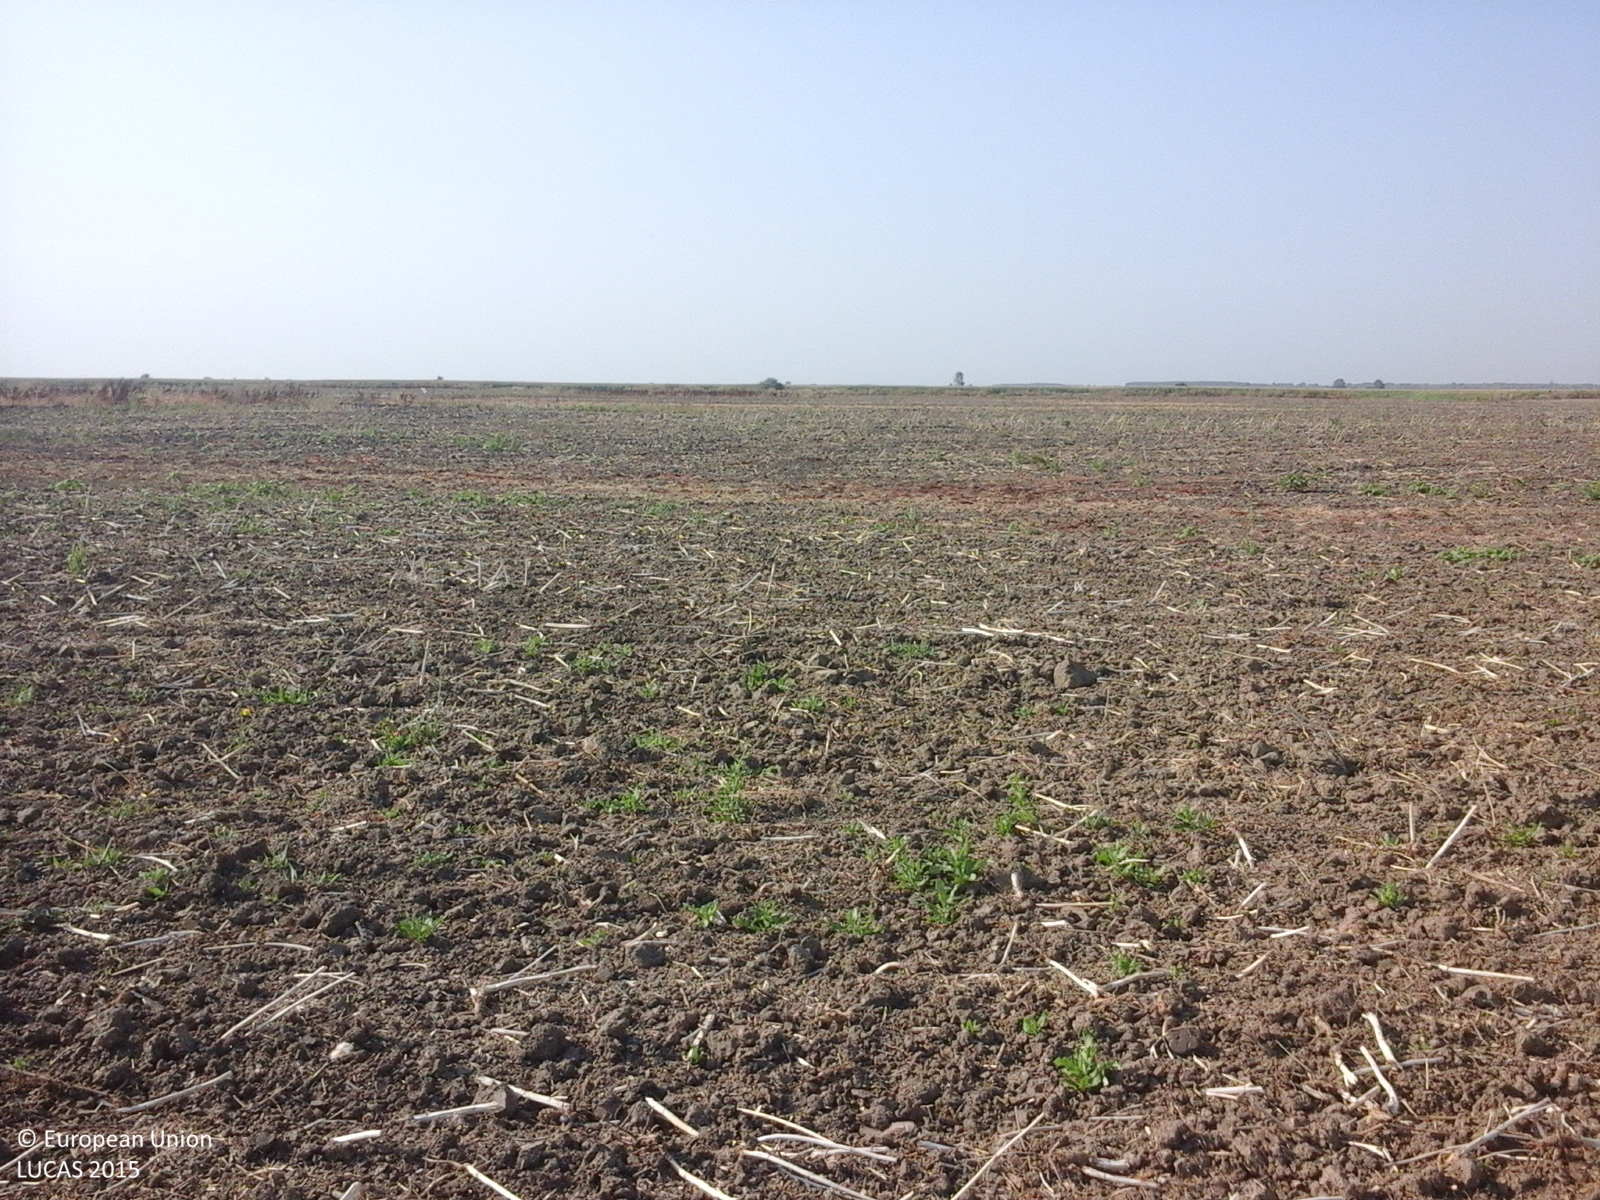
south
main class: Cropland
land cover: Rape and turnip rape
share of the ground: < 10 %
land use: Agriculture (excluding fallow land and kitchen gardens)
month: August
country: RO
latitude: 45.2517
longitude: 27.9917
